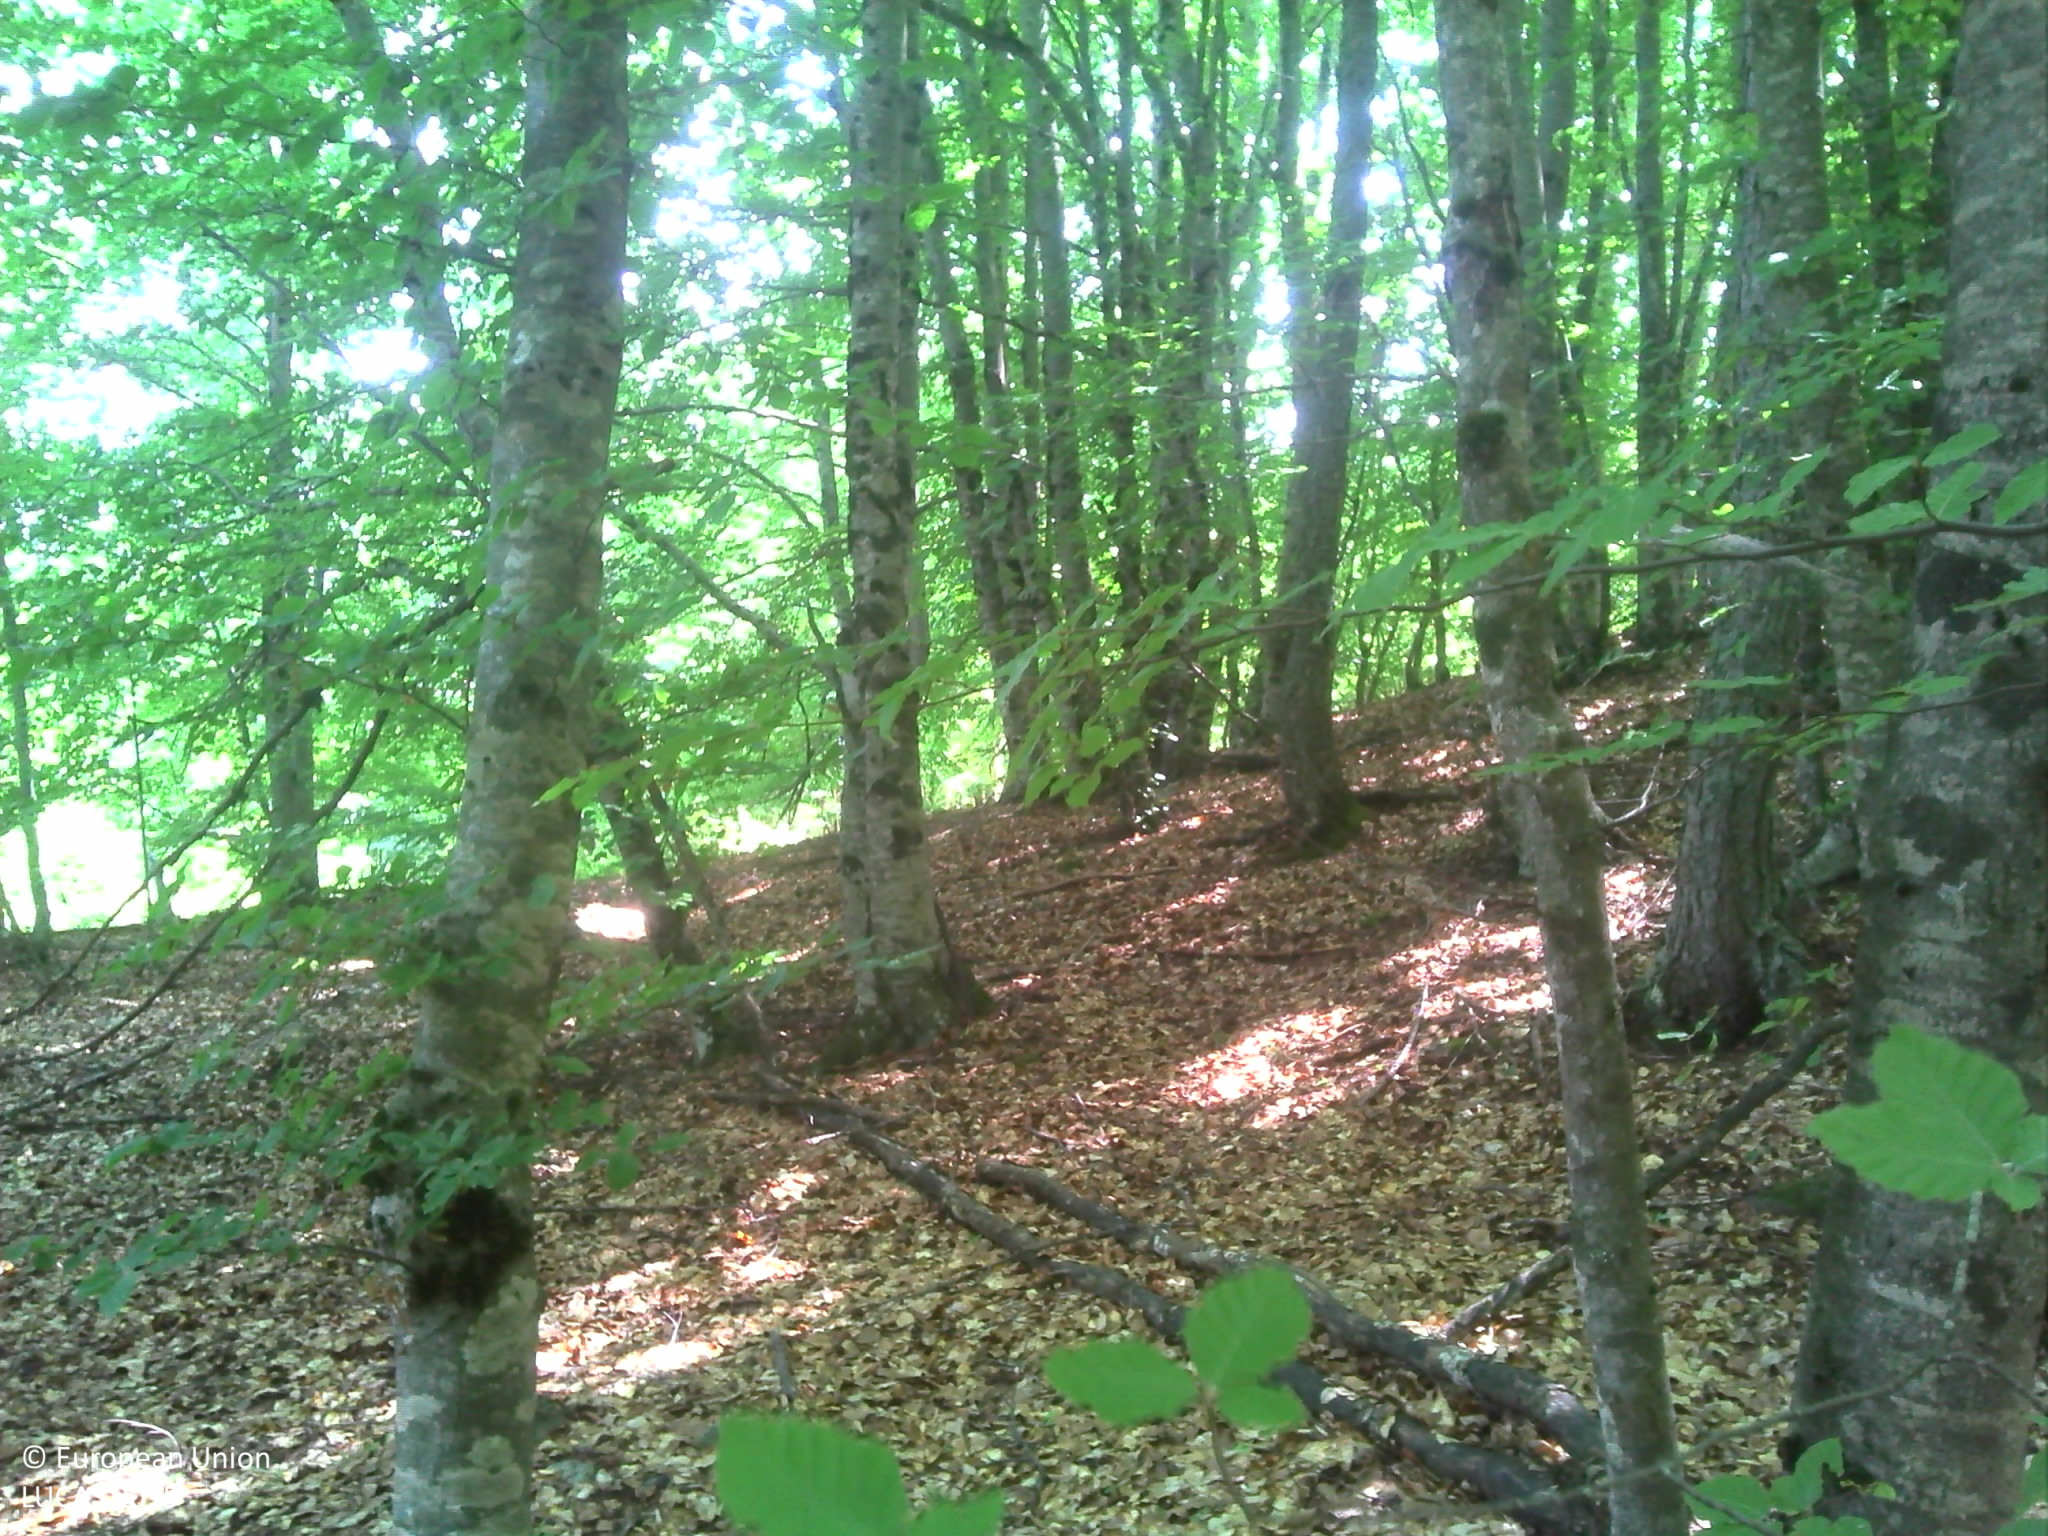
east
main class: Woodland
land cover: Broadleaved woodland
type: beech forest
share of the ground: > 75 %
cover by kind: broadleaved forest trees 85 %, shrubs 5 %, herbaceous plants 5 %, lichens and mosses 5 %
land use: Forestry
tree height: > 5 m
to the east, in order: Broadleaved woodland; Pine dominated coniferous woodland; Tracks; Other mixed woodland; Grassland without tree/shrub cover; Spruce dominated coniferous woodland; Grassland with sparse tree/shrub cover; Pine dominated mixed woodland; Grass margins; Electric lines; Paved roads, cycling and walking lanes; Grassland without tree/shrub cover; Electric lines; Grassland with sparse tree/shrub cover; Rocks and stones; Ditches and canals; Grass margins; Paved roads, cycling and walking lanes; Grassland without tree/shrub cover; Broadleaved woodland; Grassland with sparse tree/shrub cover
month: July
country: FR
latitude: 44.4291
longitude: 6.3010
